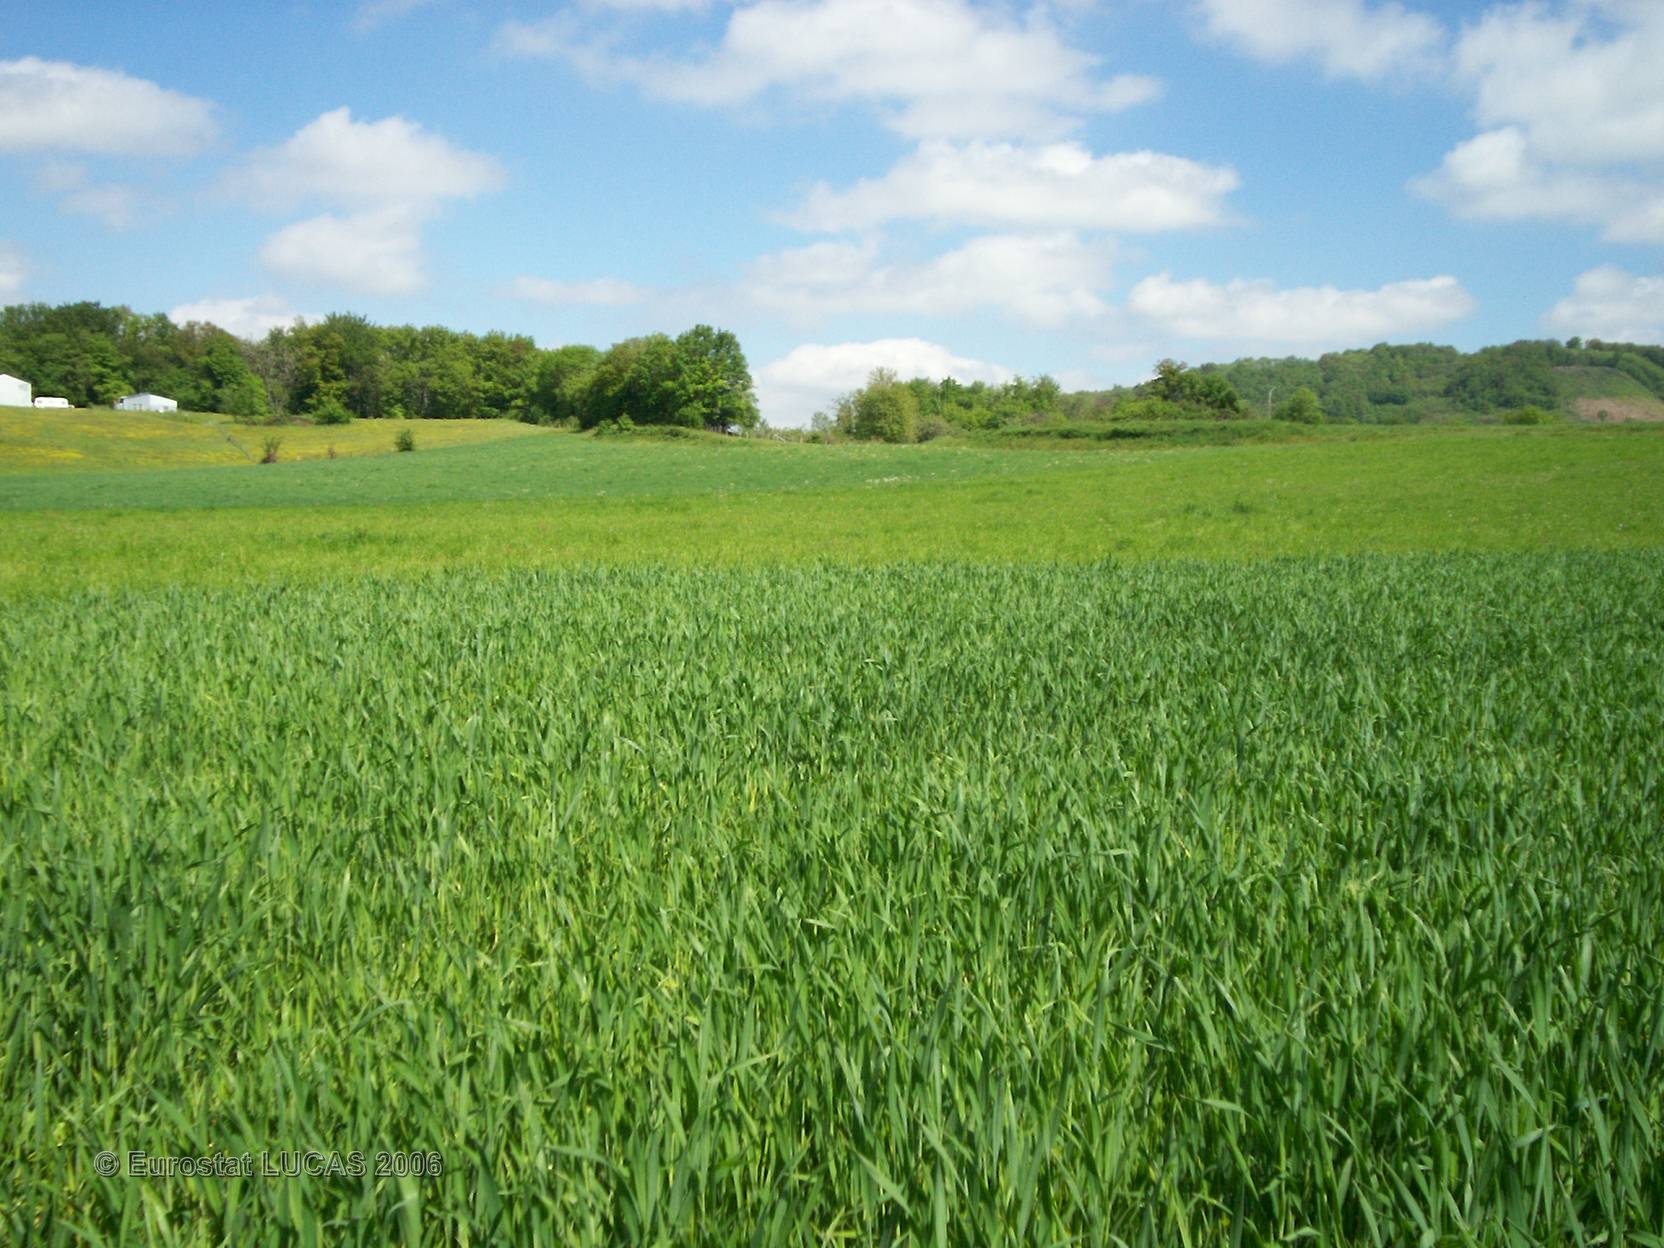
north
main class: Cropland
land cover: Common wheat
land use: Agriculture (excluding fallow land and kitchen gardens)
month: May
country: FR
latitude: 45.4409
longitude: 5.4152
